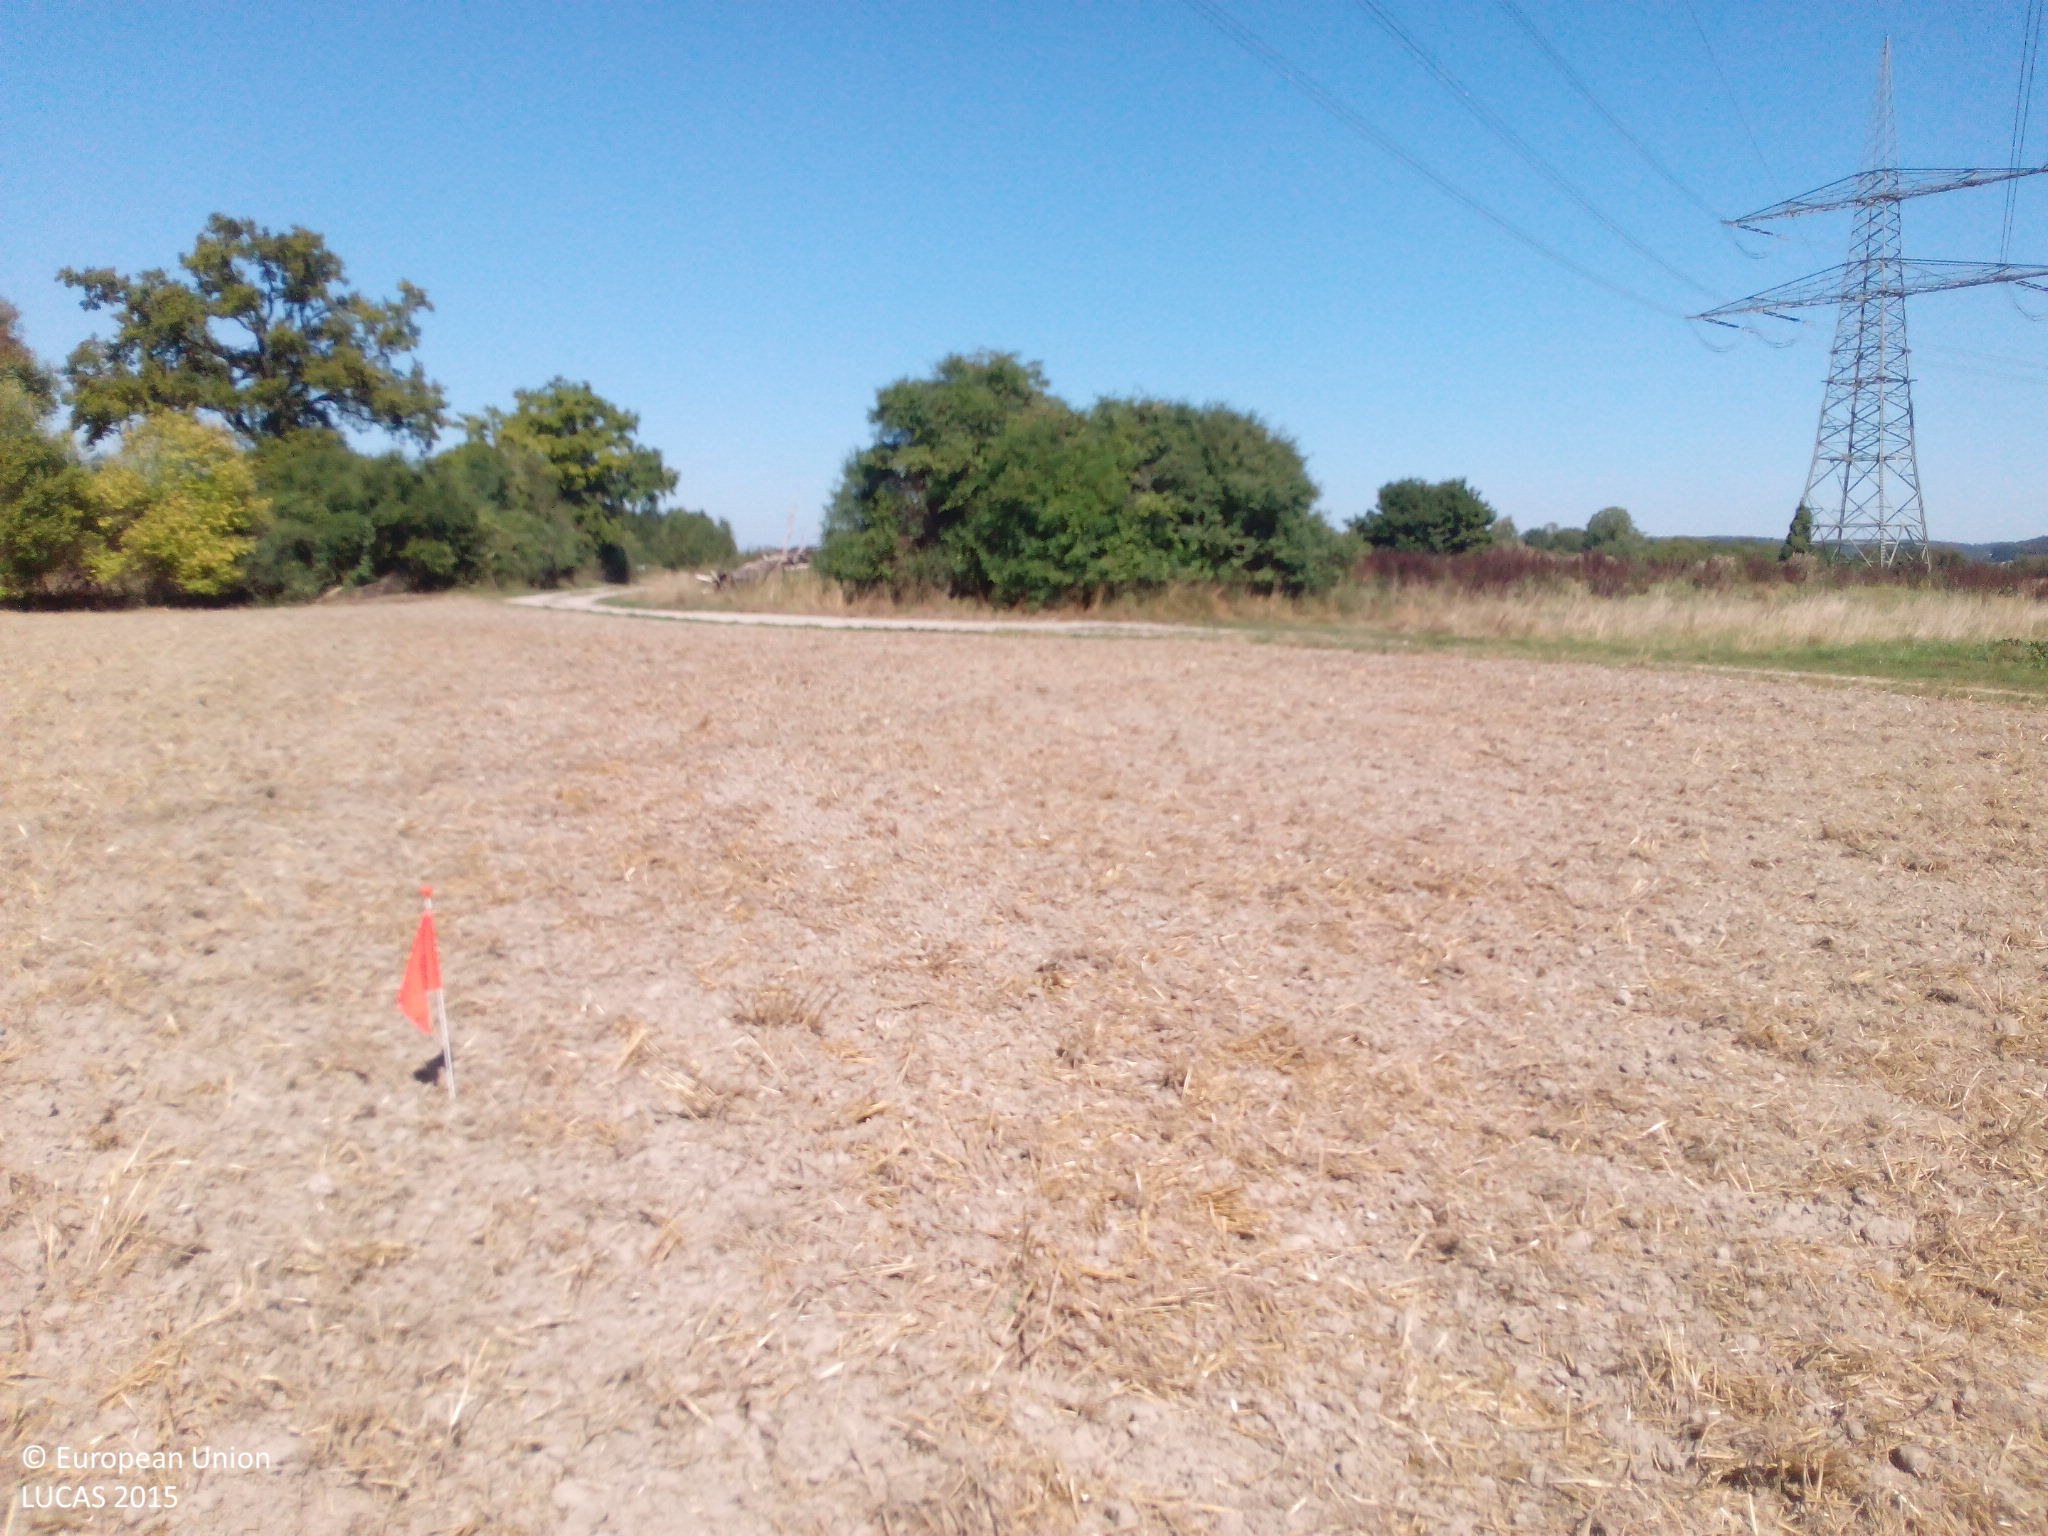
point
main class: Artificial land
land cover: Other artificial areas
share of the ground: < 10 %
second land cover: Common wheat
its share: < 10 %
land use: Electricity, gas and thermal power distribution
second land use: Agriculture (excluding fallow land and kitchen gardens)
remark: Harvested field
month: August
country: DE
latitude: 48.5439
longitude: 10.8800
